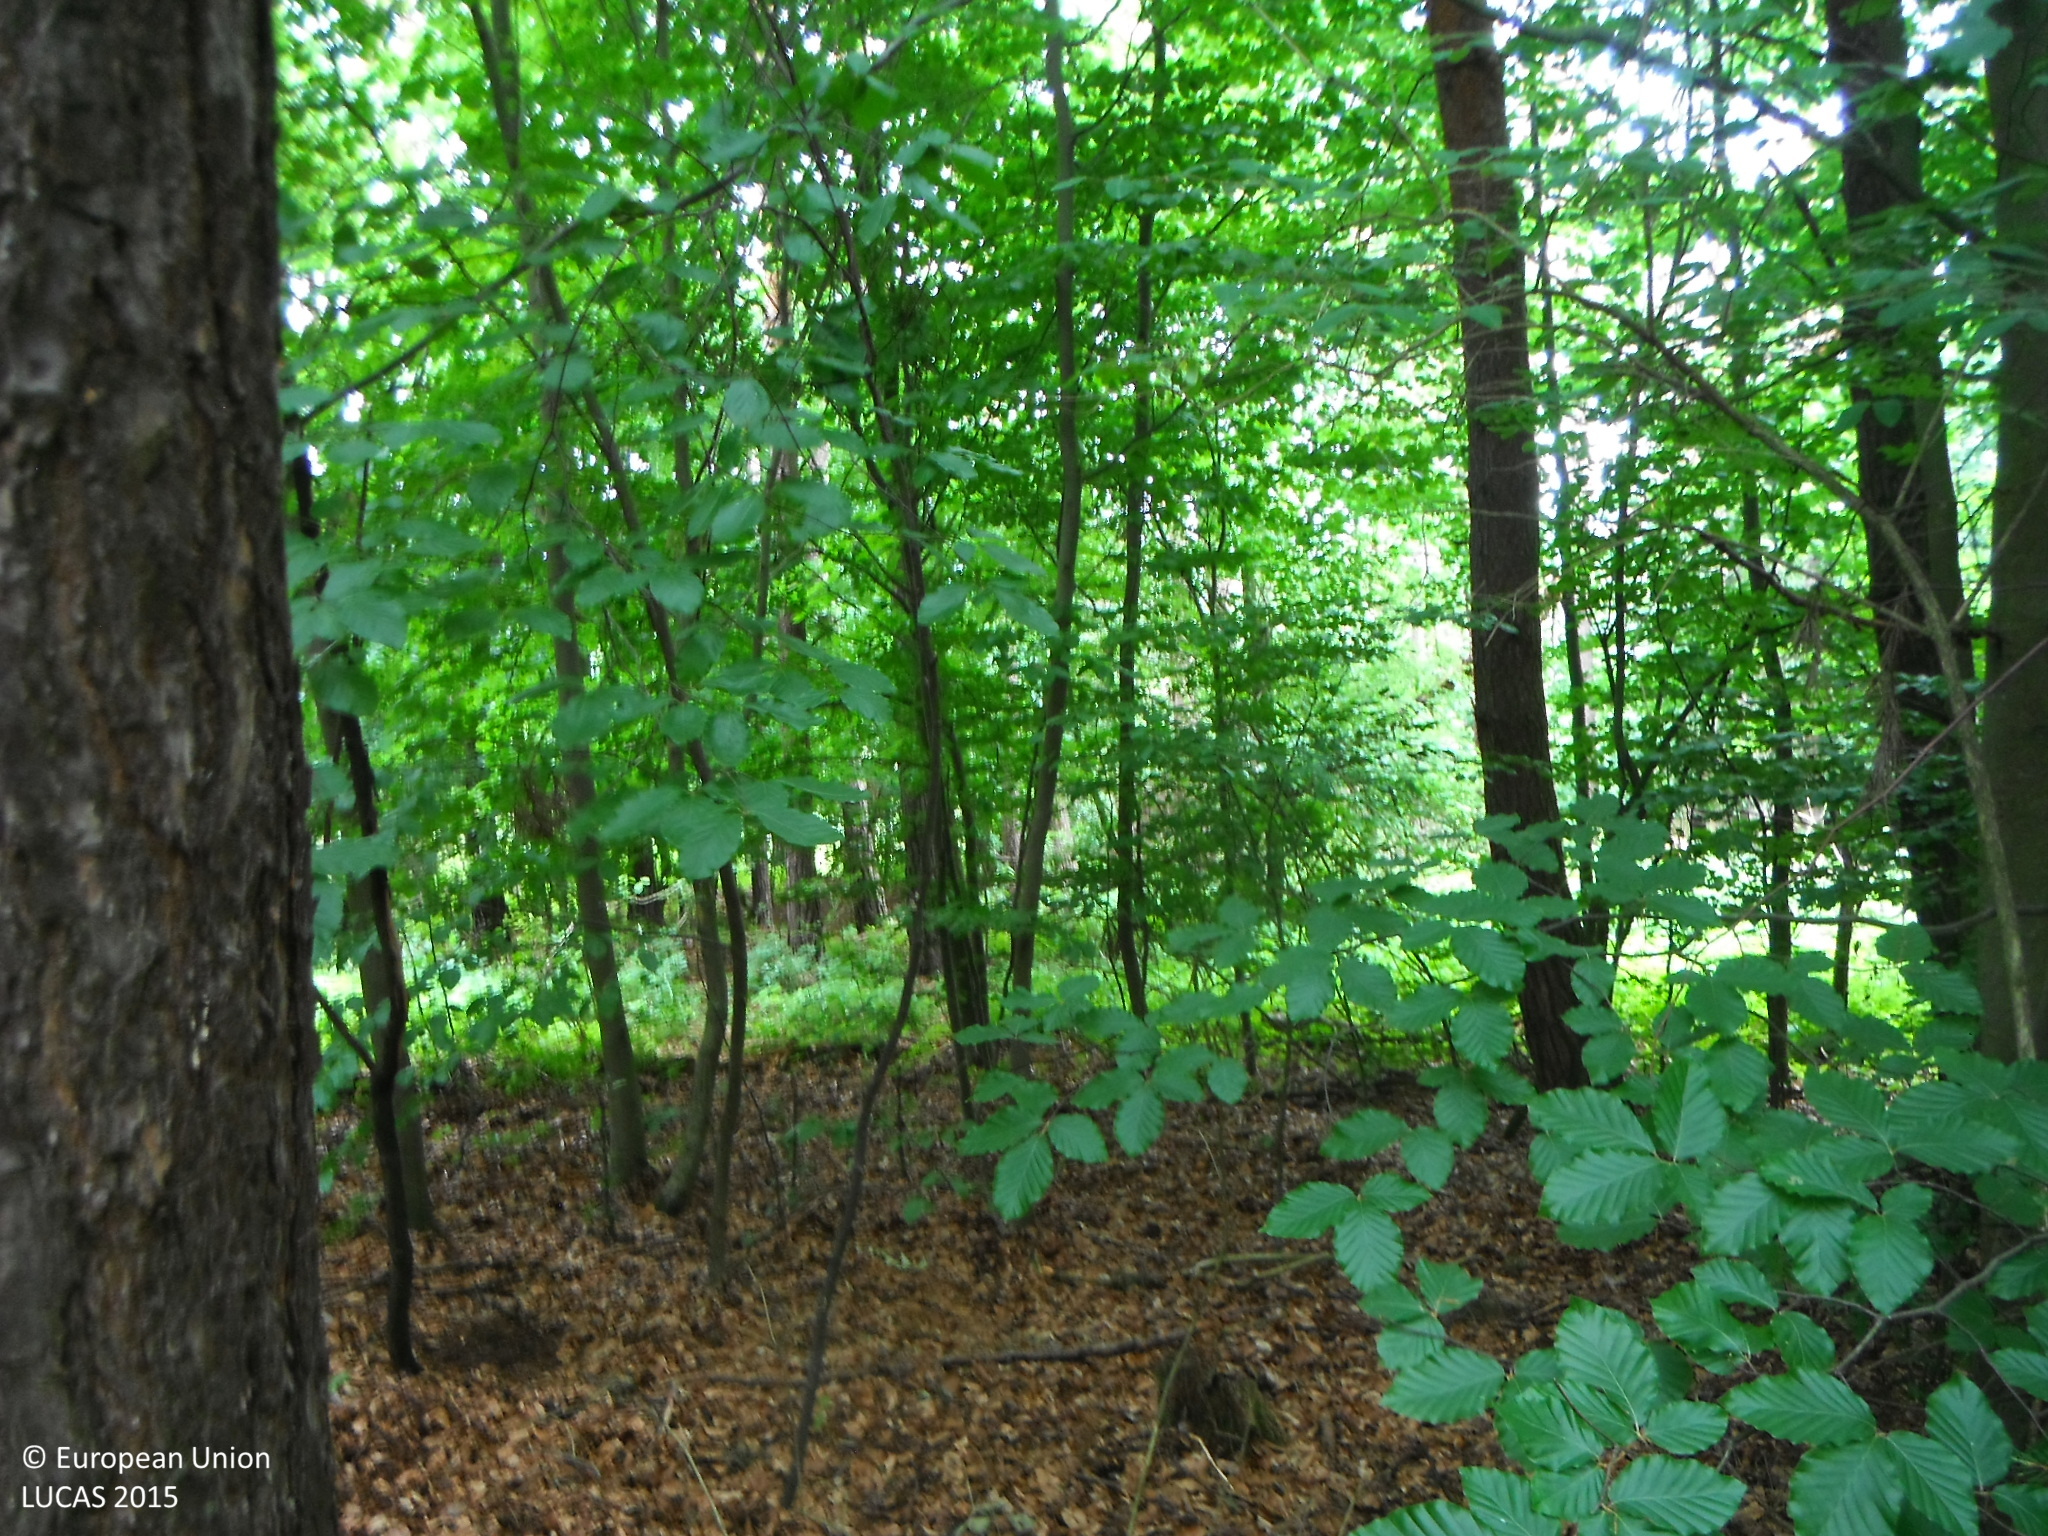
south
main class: Woodland
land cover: Other mixed woodland
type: hemiboreal forest and nemoral coniferous forest and mixed broadleaved-coniferous forest
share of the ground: > 75 %
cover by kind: broadleaved forest trees 60 %, coniferous forest trees 40 %
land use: Forestry
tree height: > 5 m
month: June
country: SK
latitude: 49.0042
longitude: 20.5488
